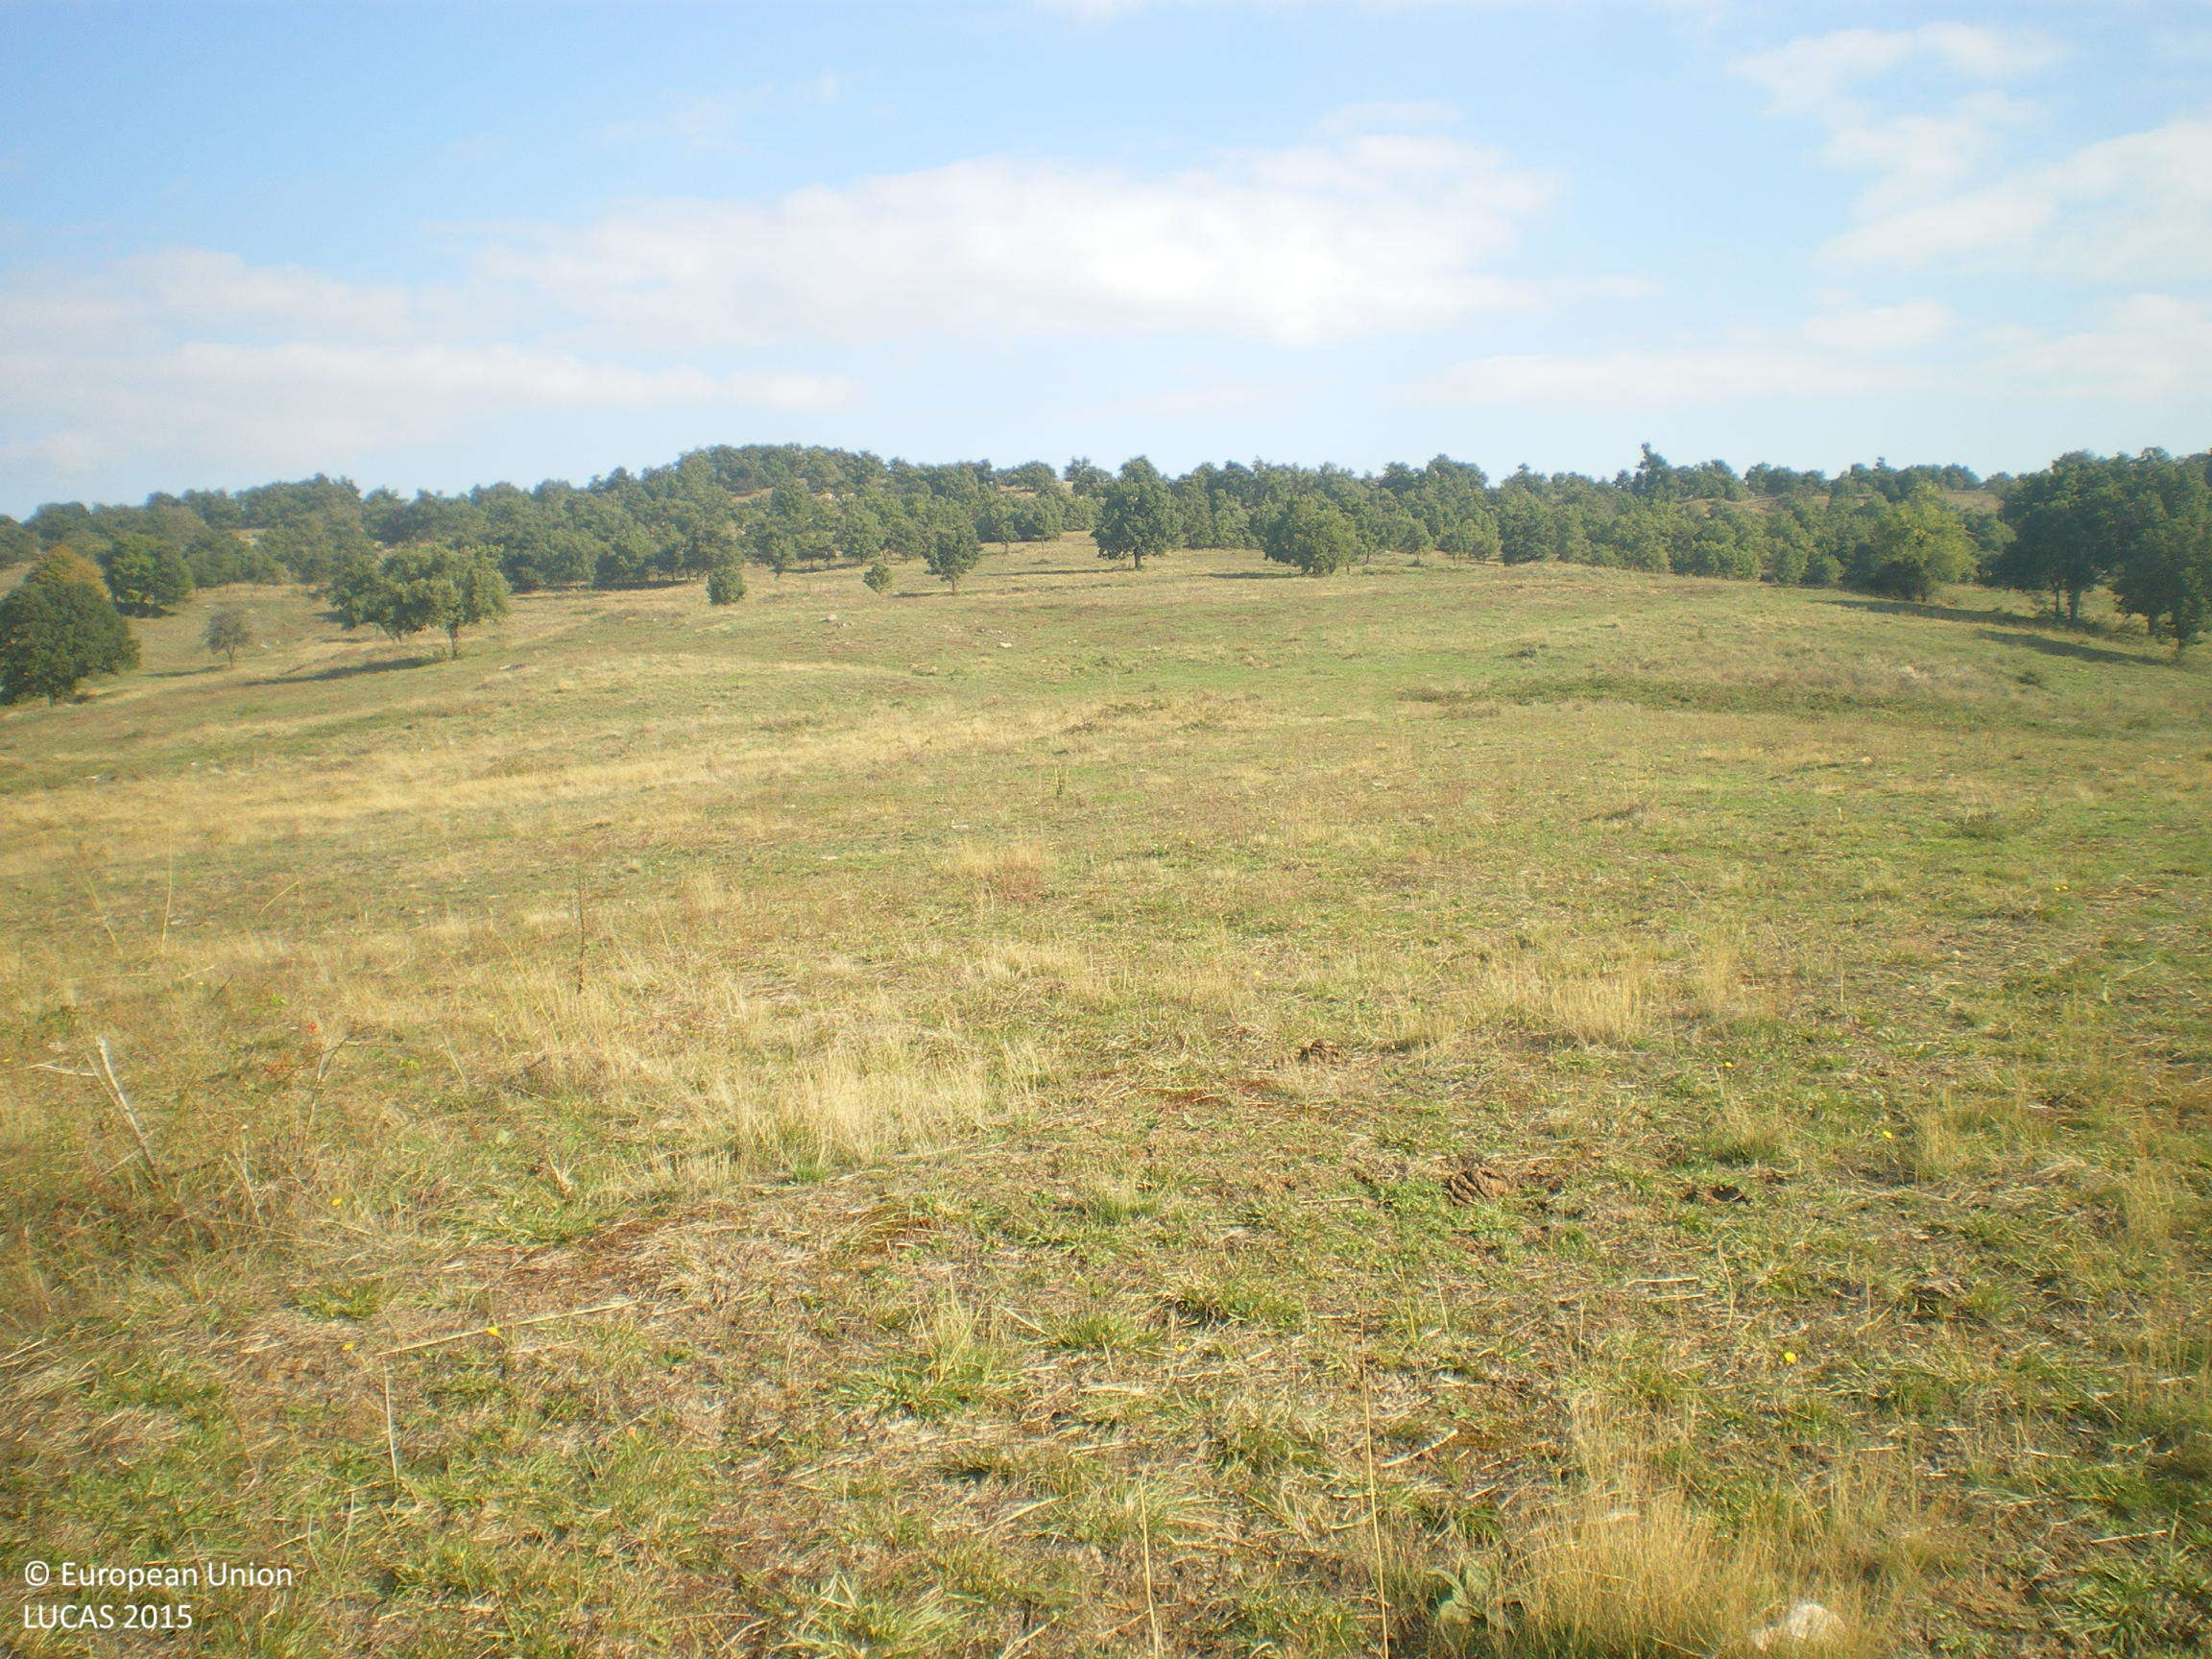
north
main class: Grassland
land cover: Grassland without tree/shrub cover
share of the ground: > 75 %
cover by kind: herbaceous plants 100 %
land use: Agriculture (excluding fallow land and kitchen gardens)
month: October
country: BG
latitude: 41.9982
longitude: 26.2202
